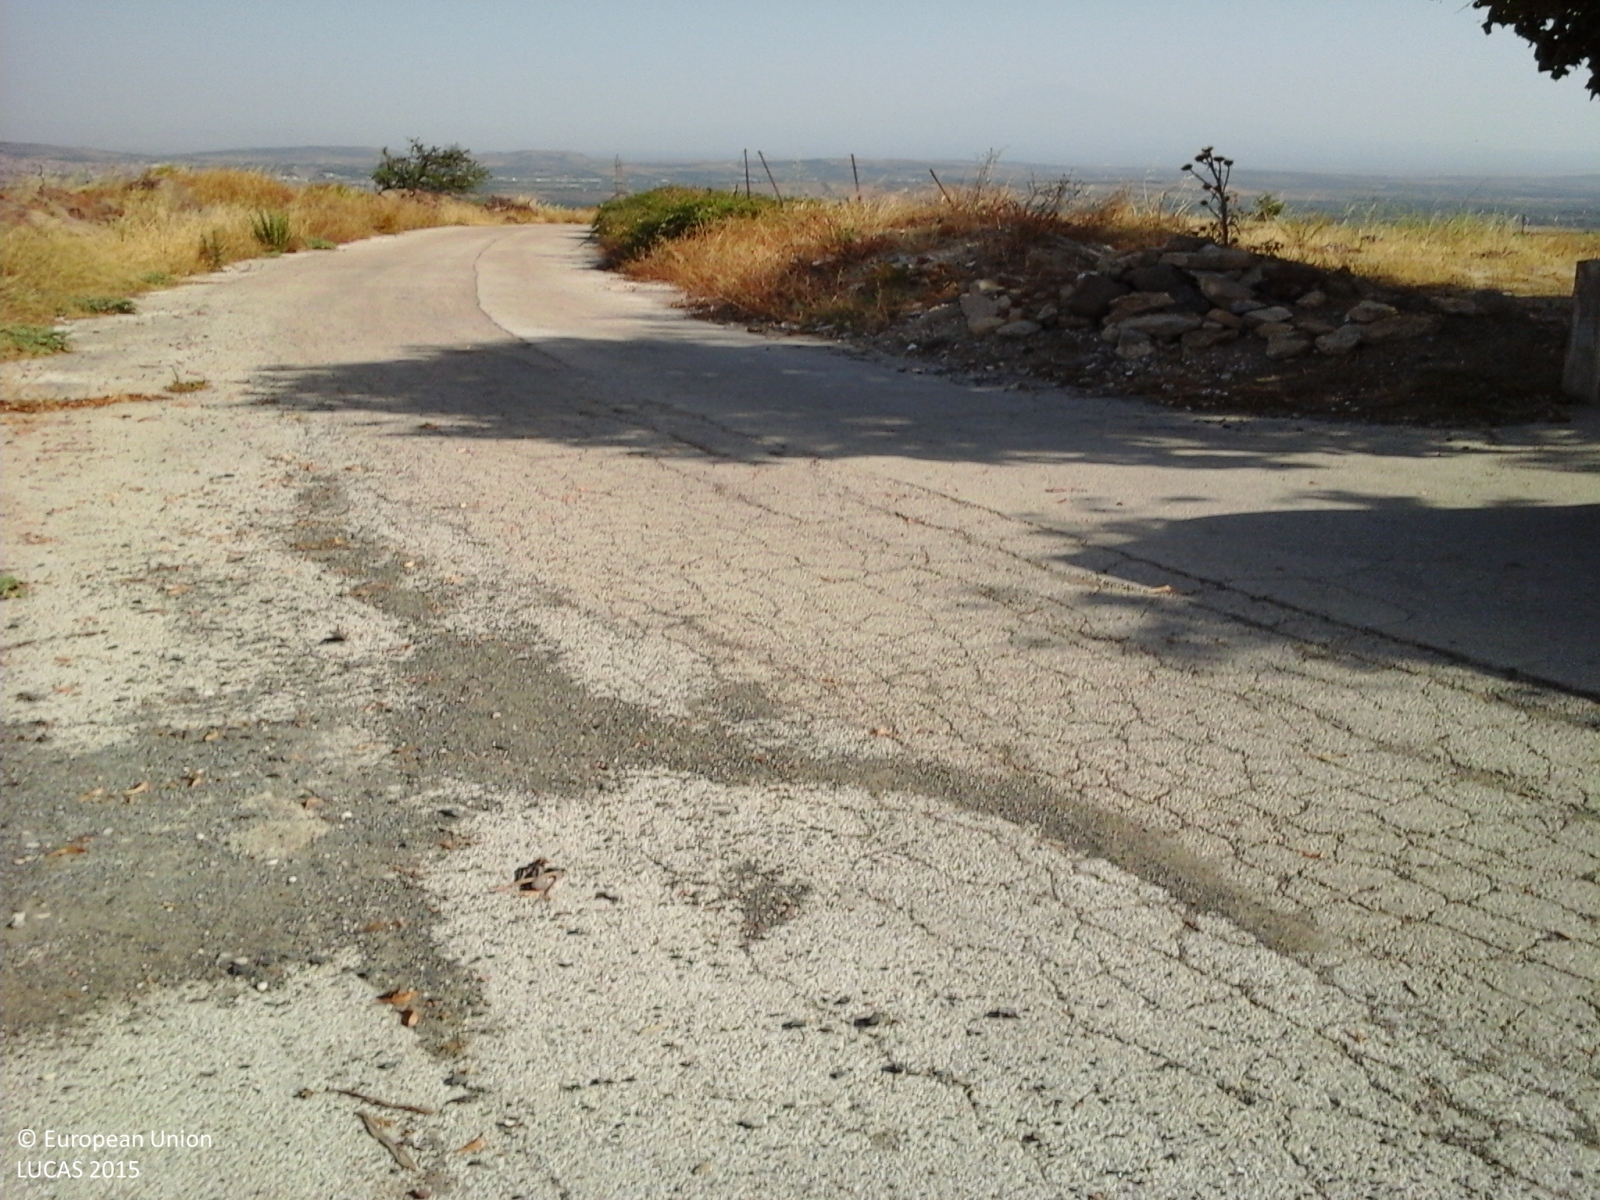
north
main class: Grassland
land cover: Grassland without tree/shrub cover
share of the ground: > 75 %
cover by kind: herbaceous plants 95 %, consolidated bare surface 5 %
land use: Agriculture (excluding fallow land and kitchen gardens)
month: August
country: IT
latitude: 37.2410
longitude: 14.8669
